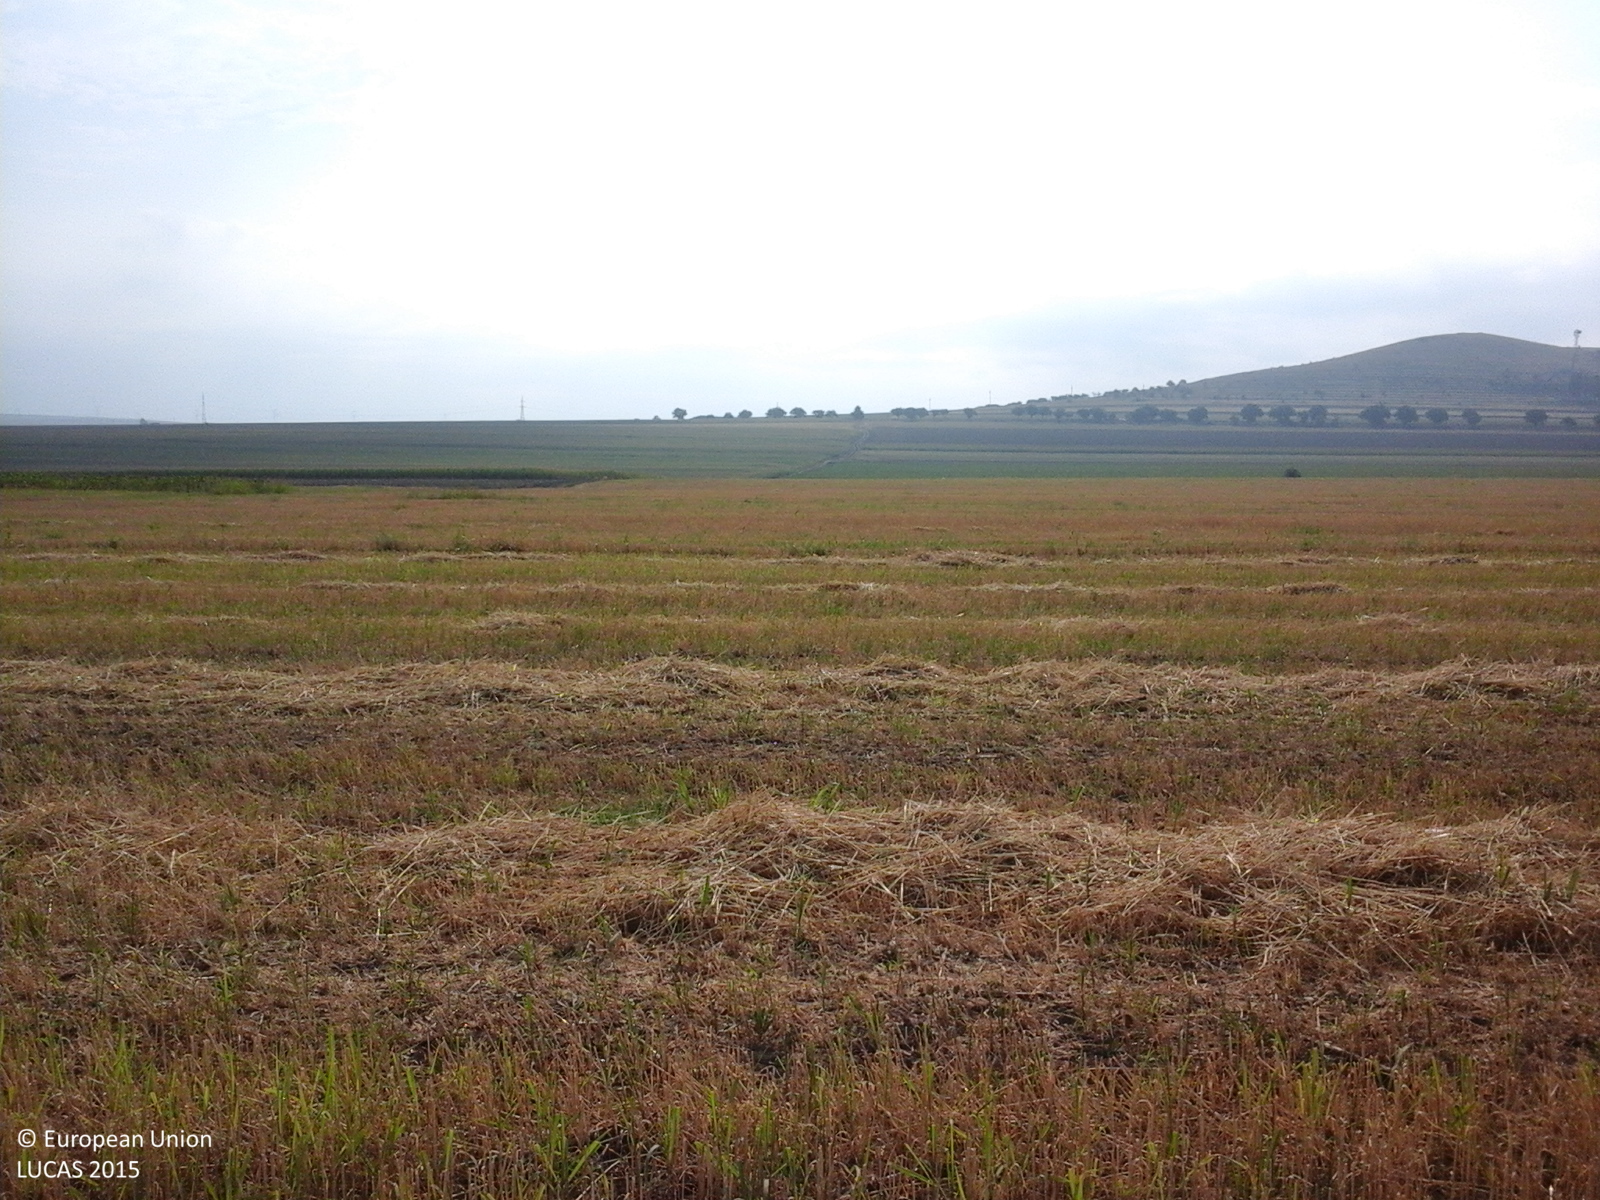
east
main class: Cropland
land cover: Durum wheat
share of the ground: > 75 %
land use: Agriculture (excluding fallow land and kitchen gardens)
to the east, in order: Durum wheat
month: July
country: RO
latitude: 45.2823
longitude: 28.1336
